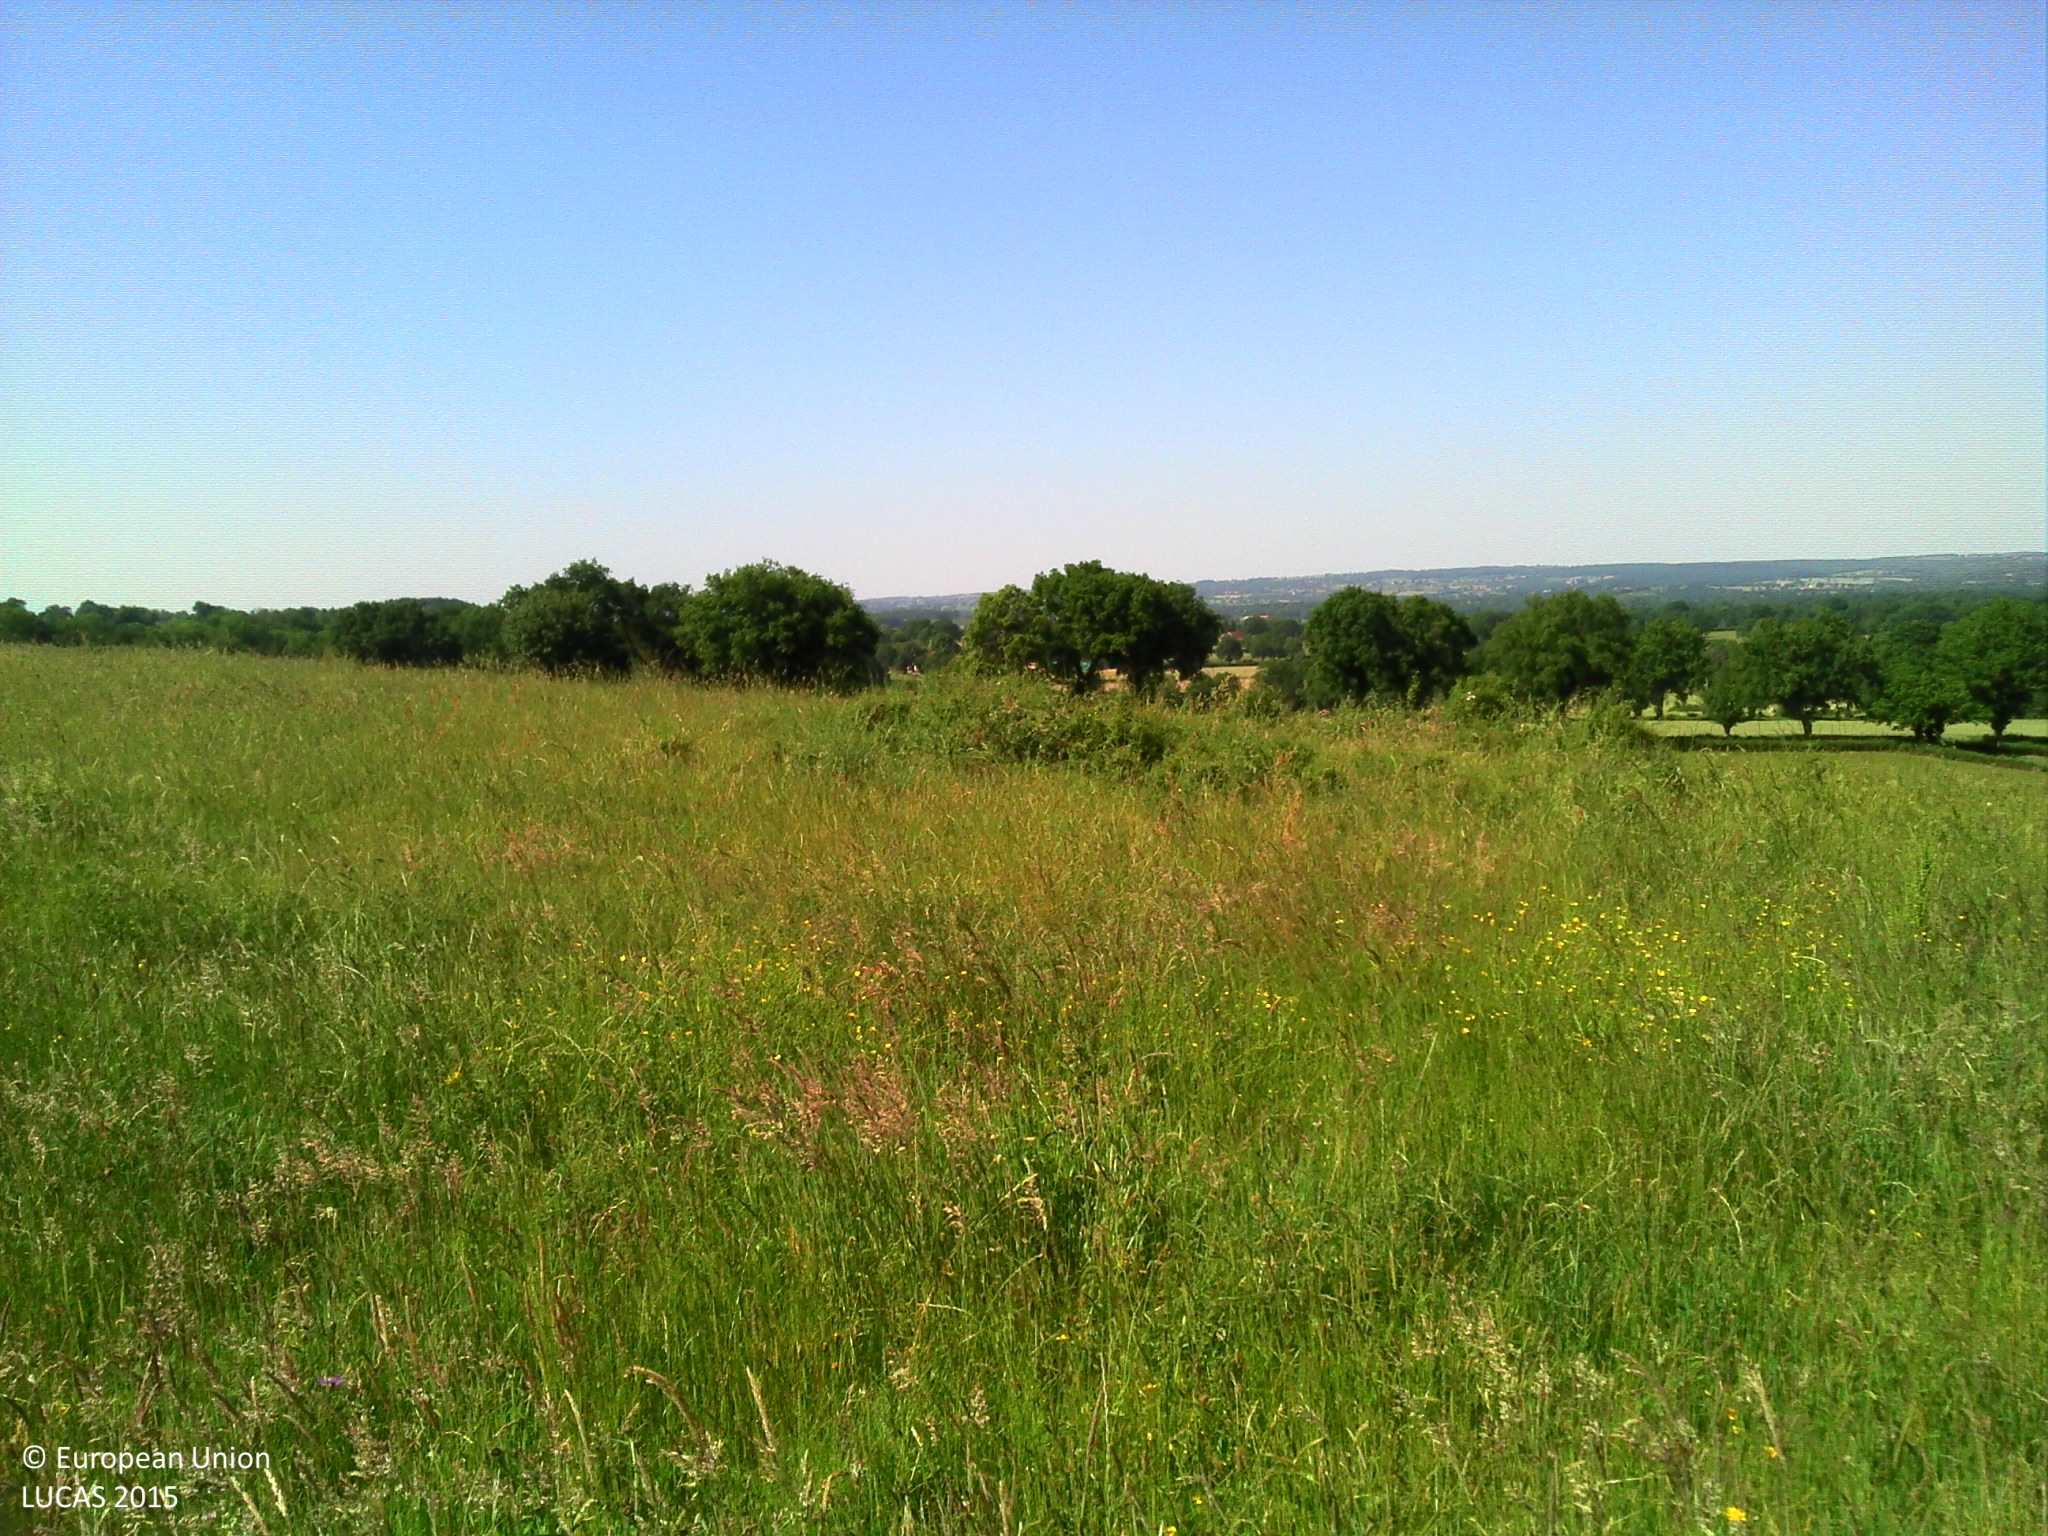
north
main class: Grassland
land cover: Grassland without tree/shrub cover
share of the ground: > 75 %
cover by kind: herbaceous plants 100 %
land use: Agriculture (excluding fallow land and kitchen gardens)
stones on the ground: < 10 %
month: June
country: FR
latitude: 46.4465
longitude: 2.7194
